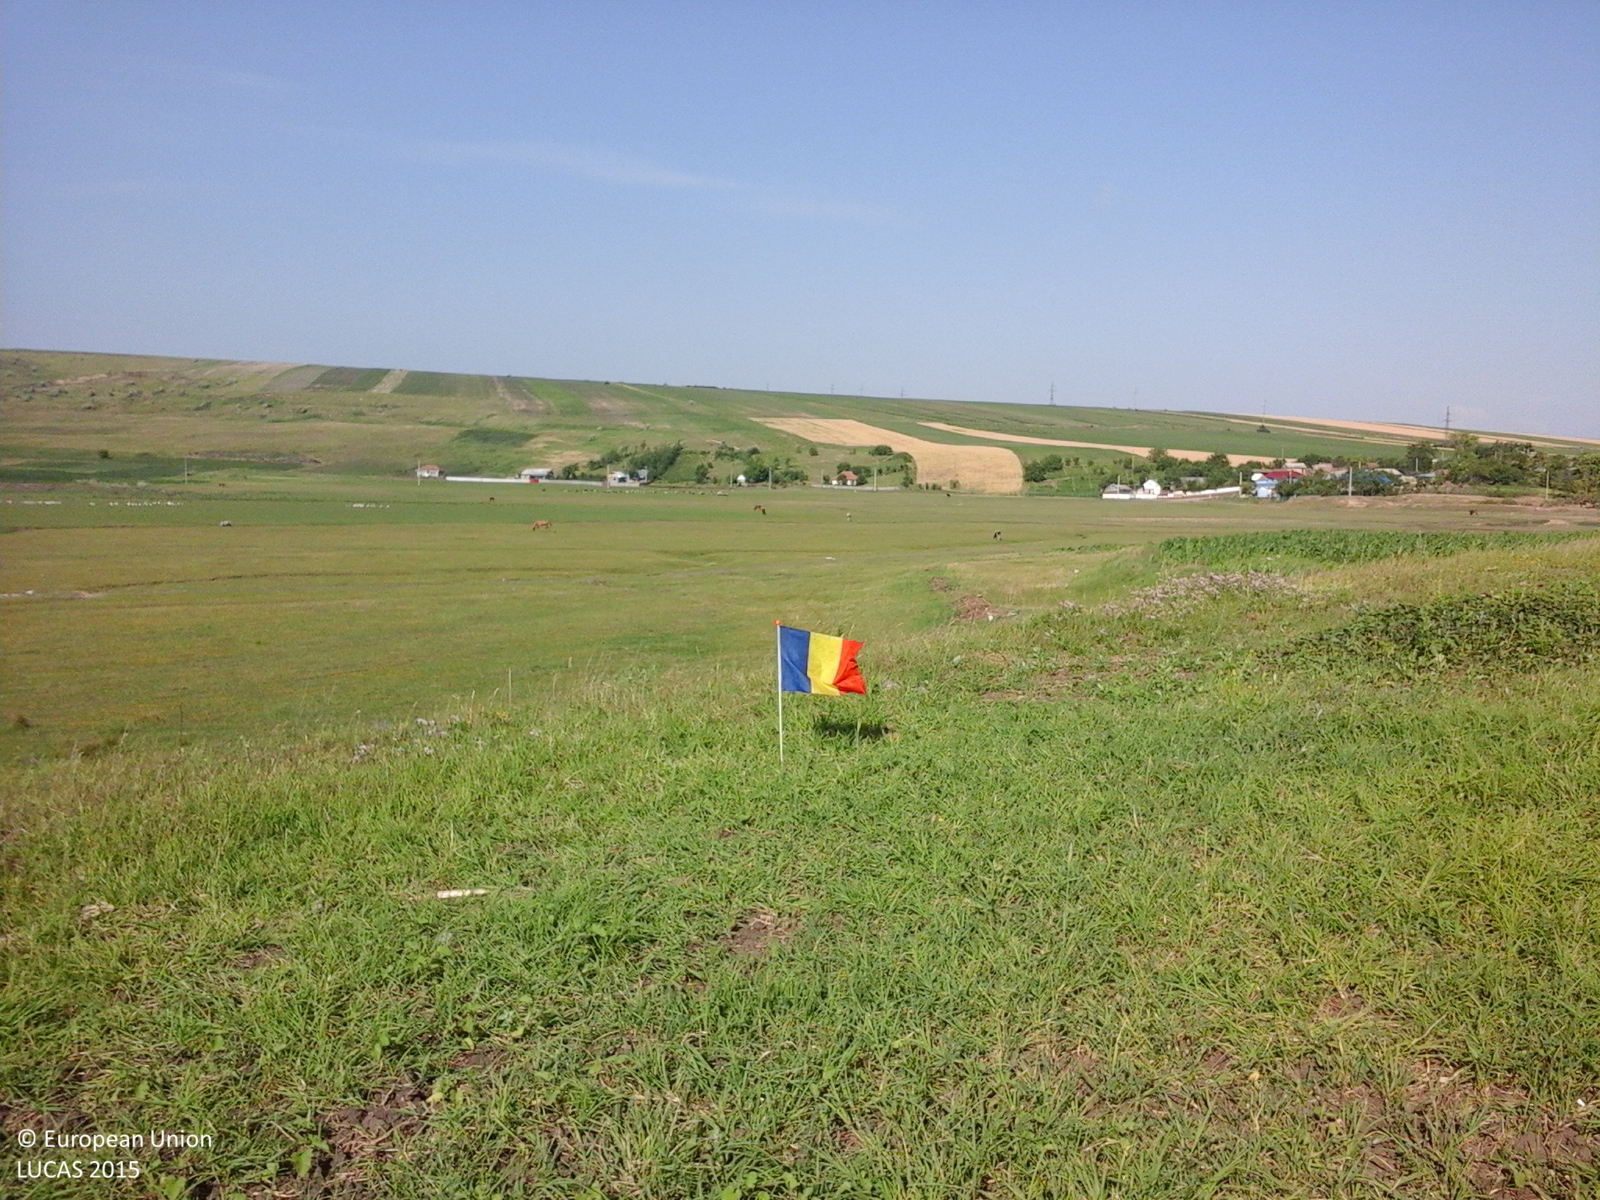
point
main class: Grassland
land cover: Grassland without tree/shrub cover
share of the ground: > 75 %
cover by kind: herbaceous plants 100 %
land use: Agriculture (excluding fallow land and kitchen gardens)
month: June
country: RO
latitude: 46.8225
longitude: 27.7511
